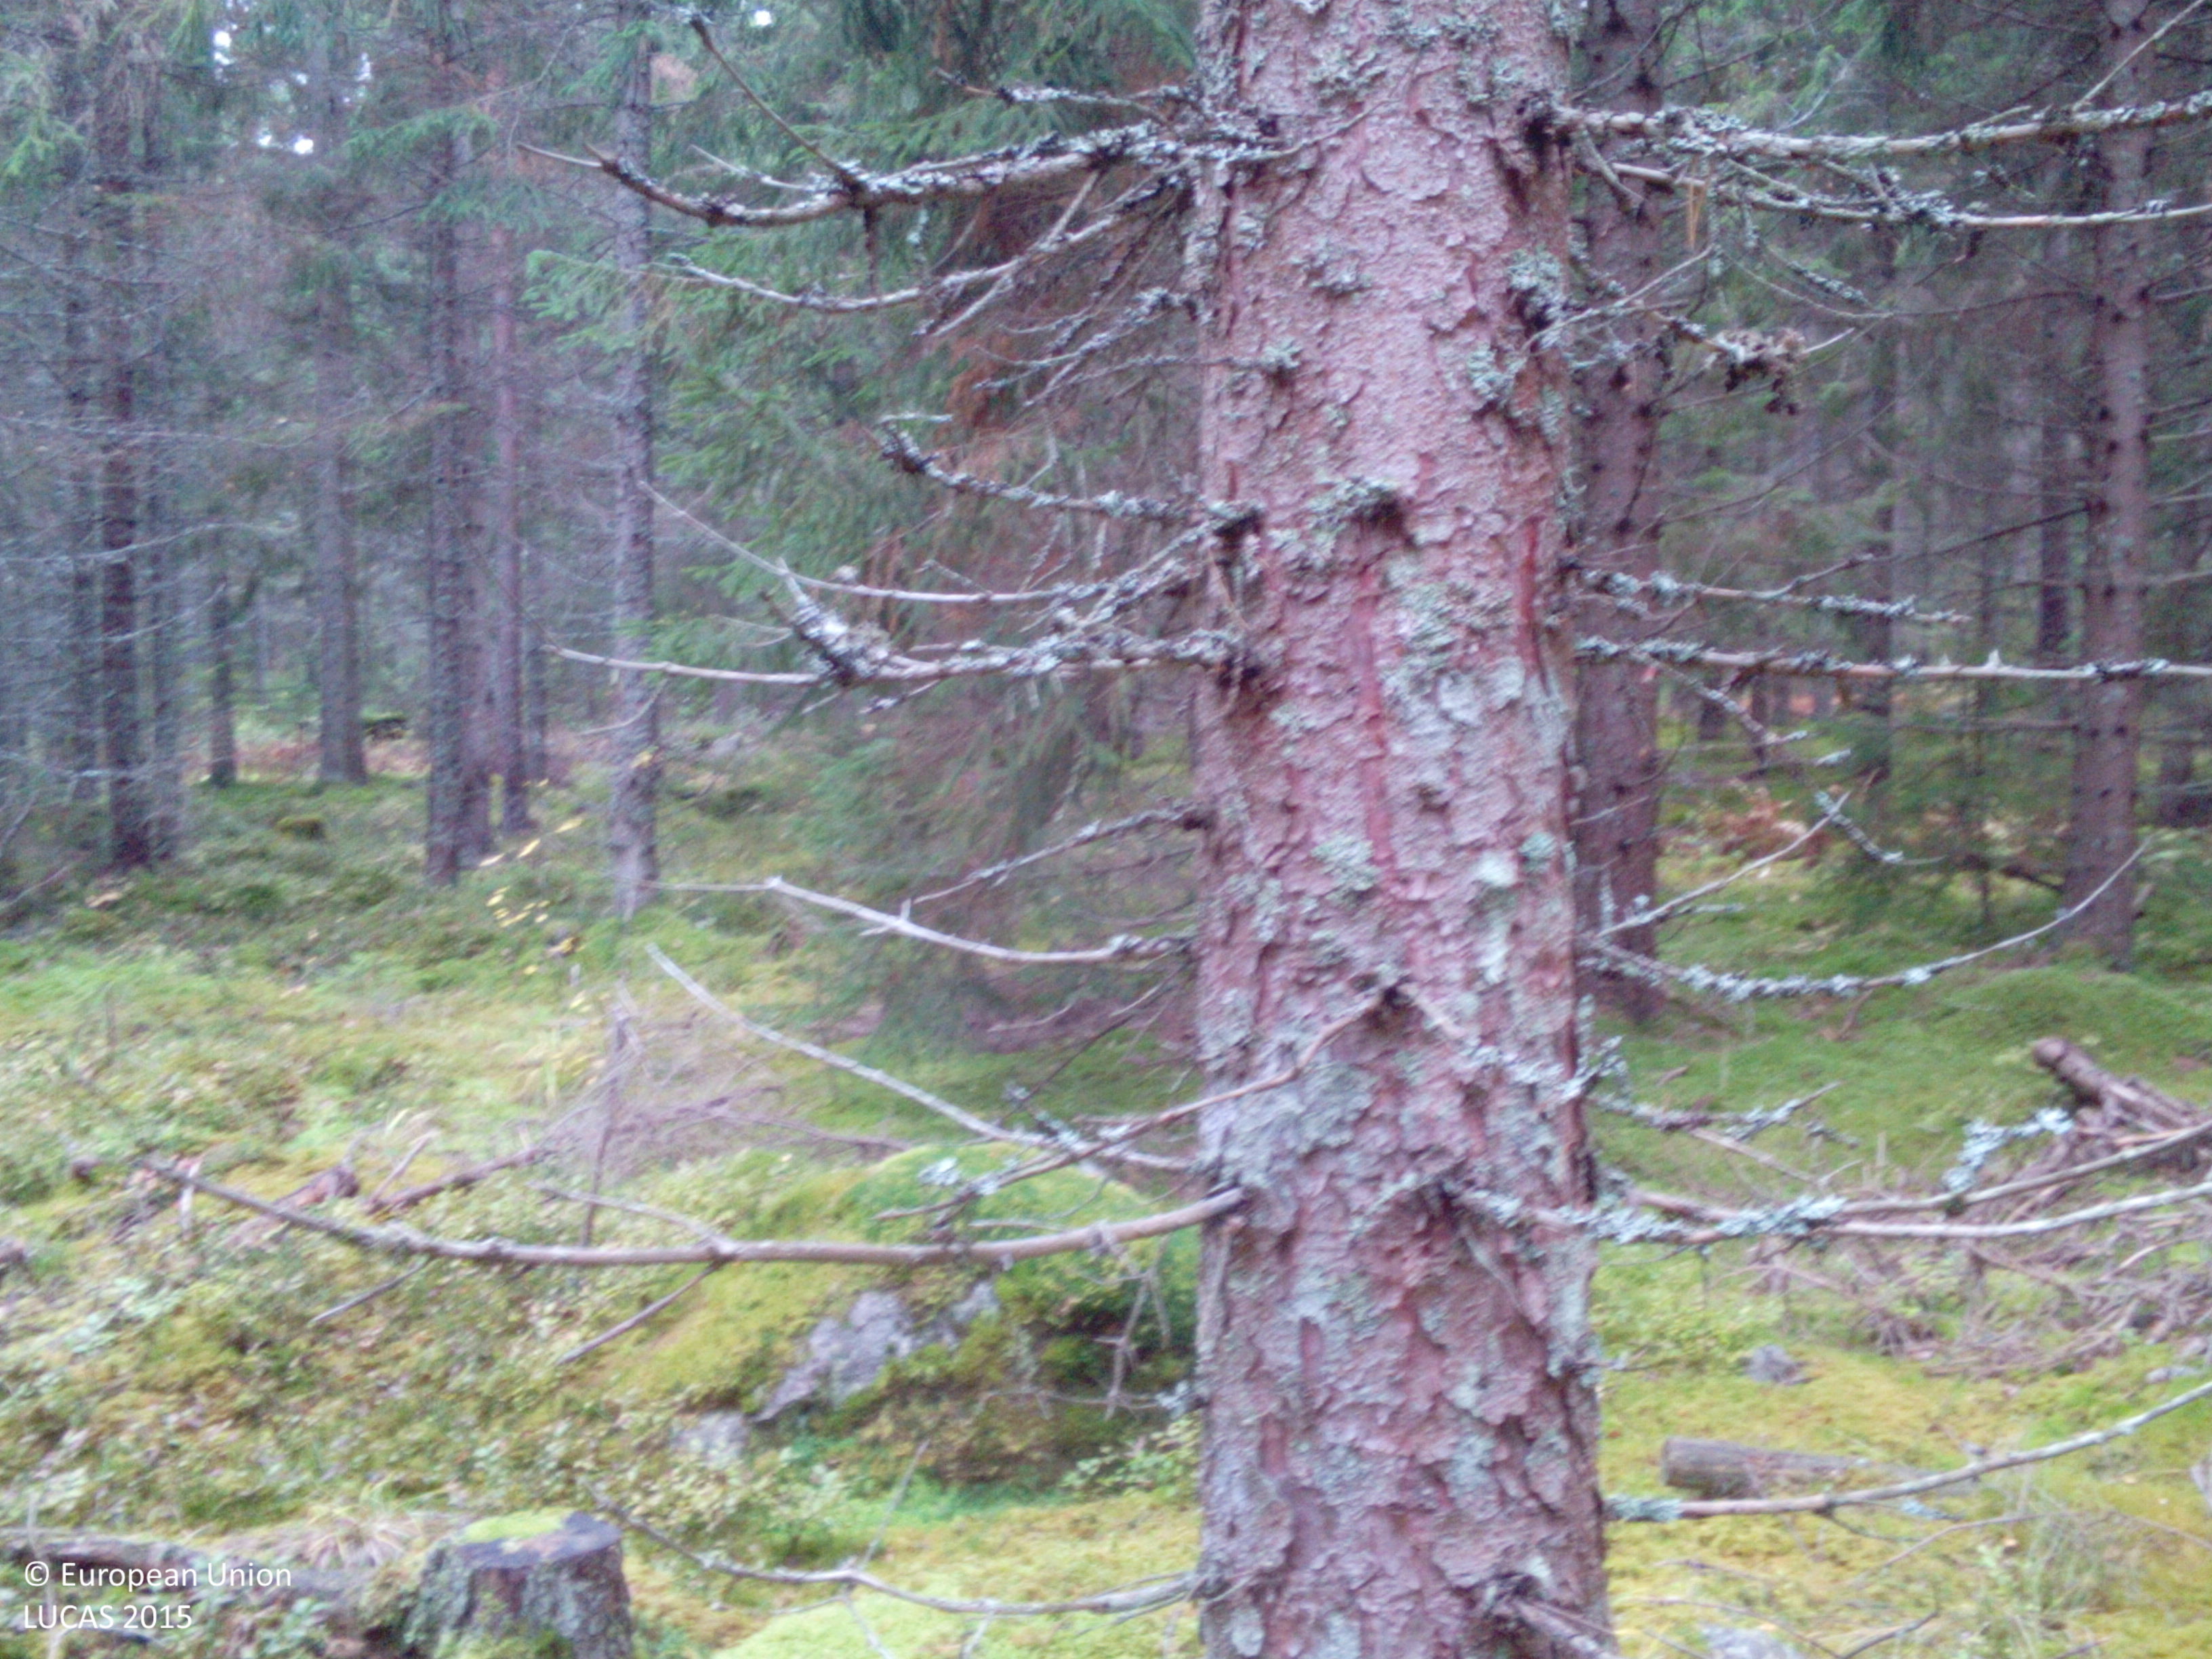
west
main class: Woodland
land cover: Spruce dominated coniferous woodland
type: boreal forest
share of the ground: > 75 %
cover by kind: coniferous forest trees 85 %, lichens and mosses 10 %, herbaceous plants 5 %
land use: Forestry
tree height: > 5 m
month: October
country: SE
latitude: 59.1937
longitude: 16.2427
